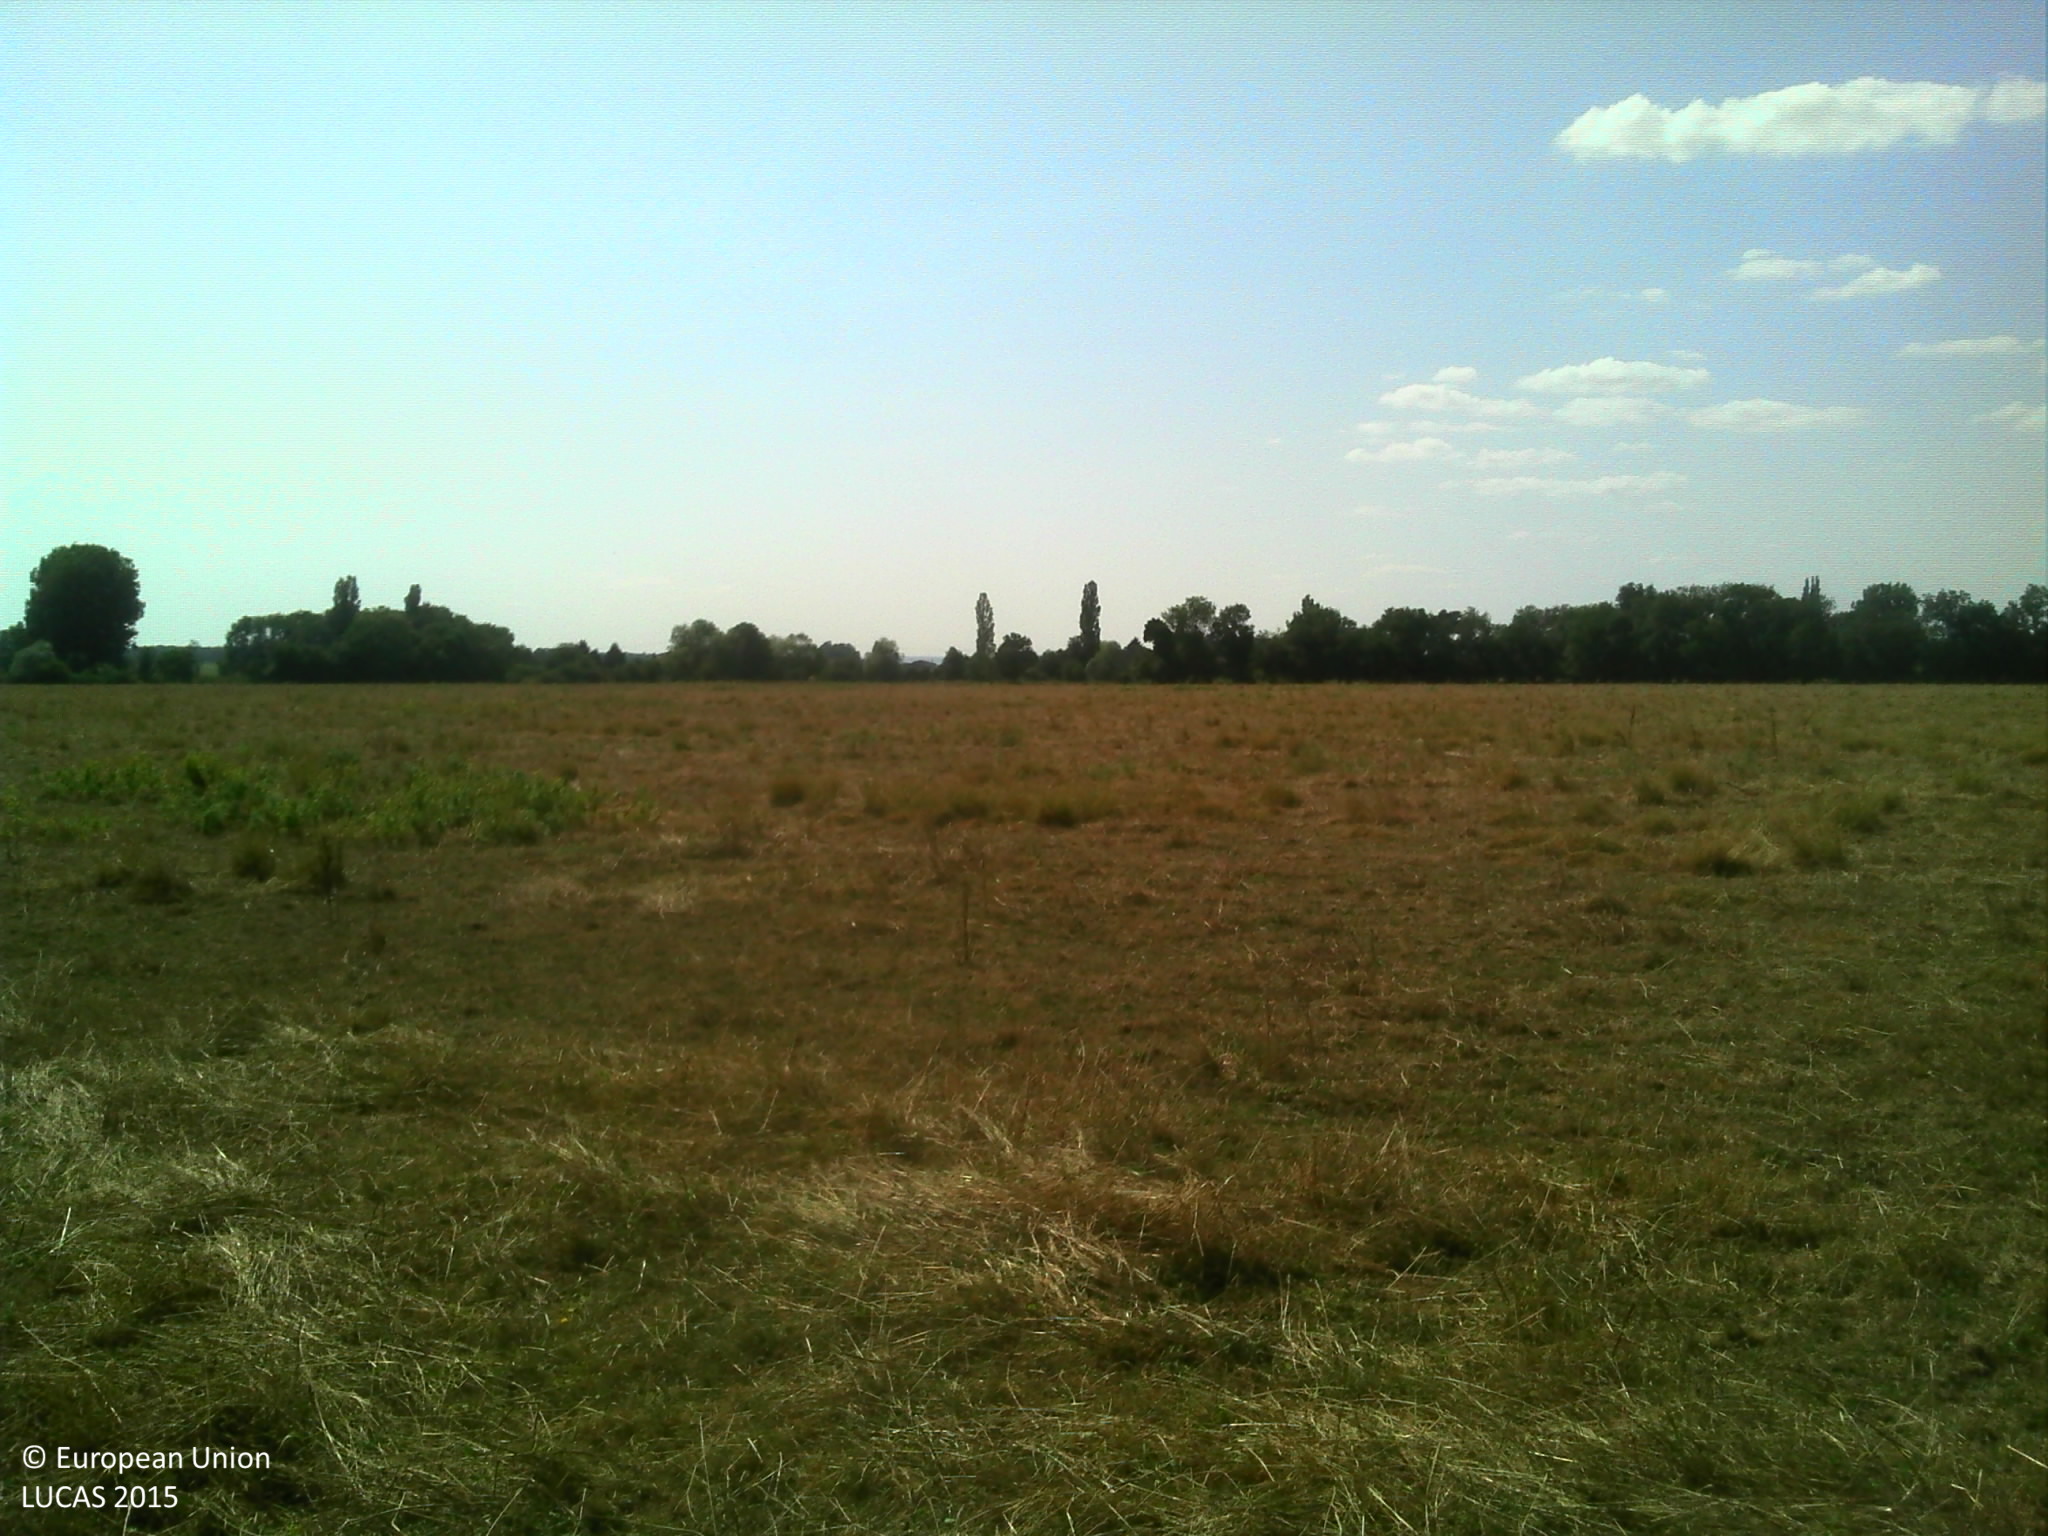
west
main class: Cropland
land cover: Maize
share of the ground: > 75 %
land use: Agriculture (excluding fallow land and kitchen gardens)
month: July
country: FR
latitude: 46.9390
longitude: 5.0226
